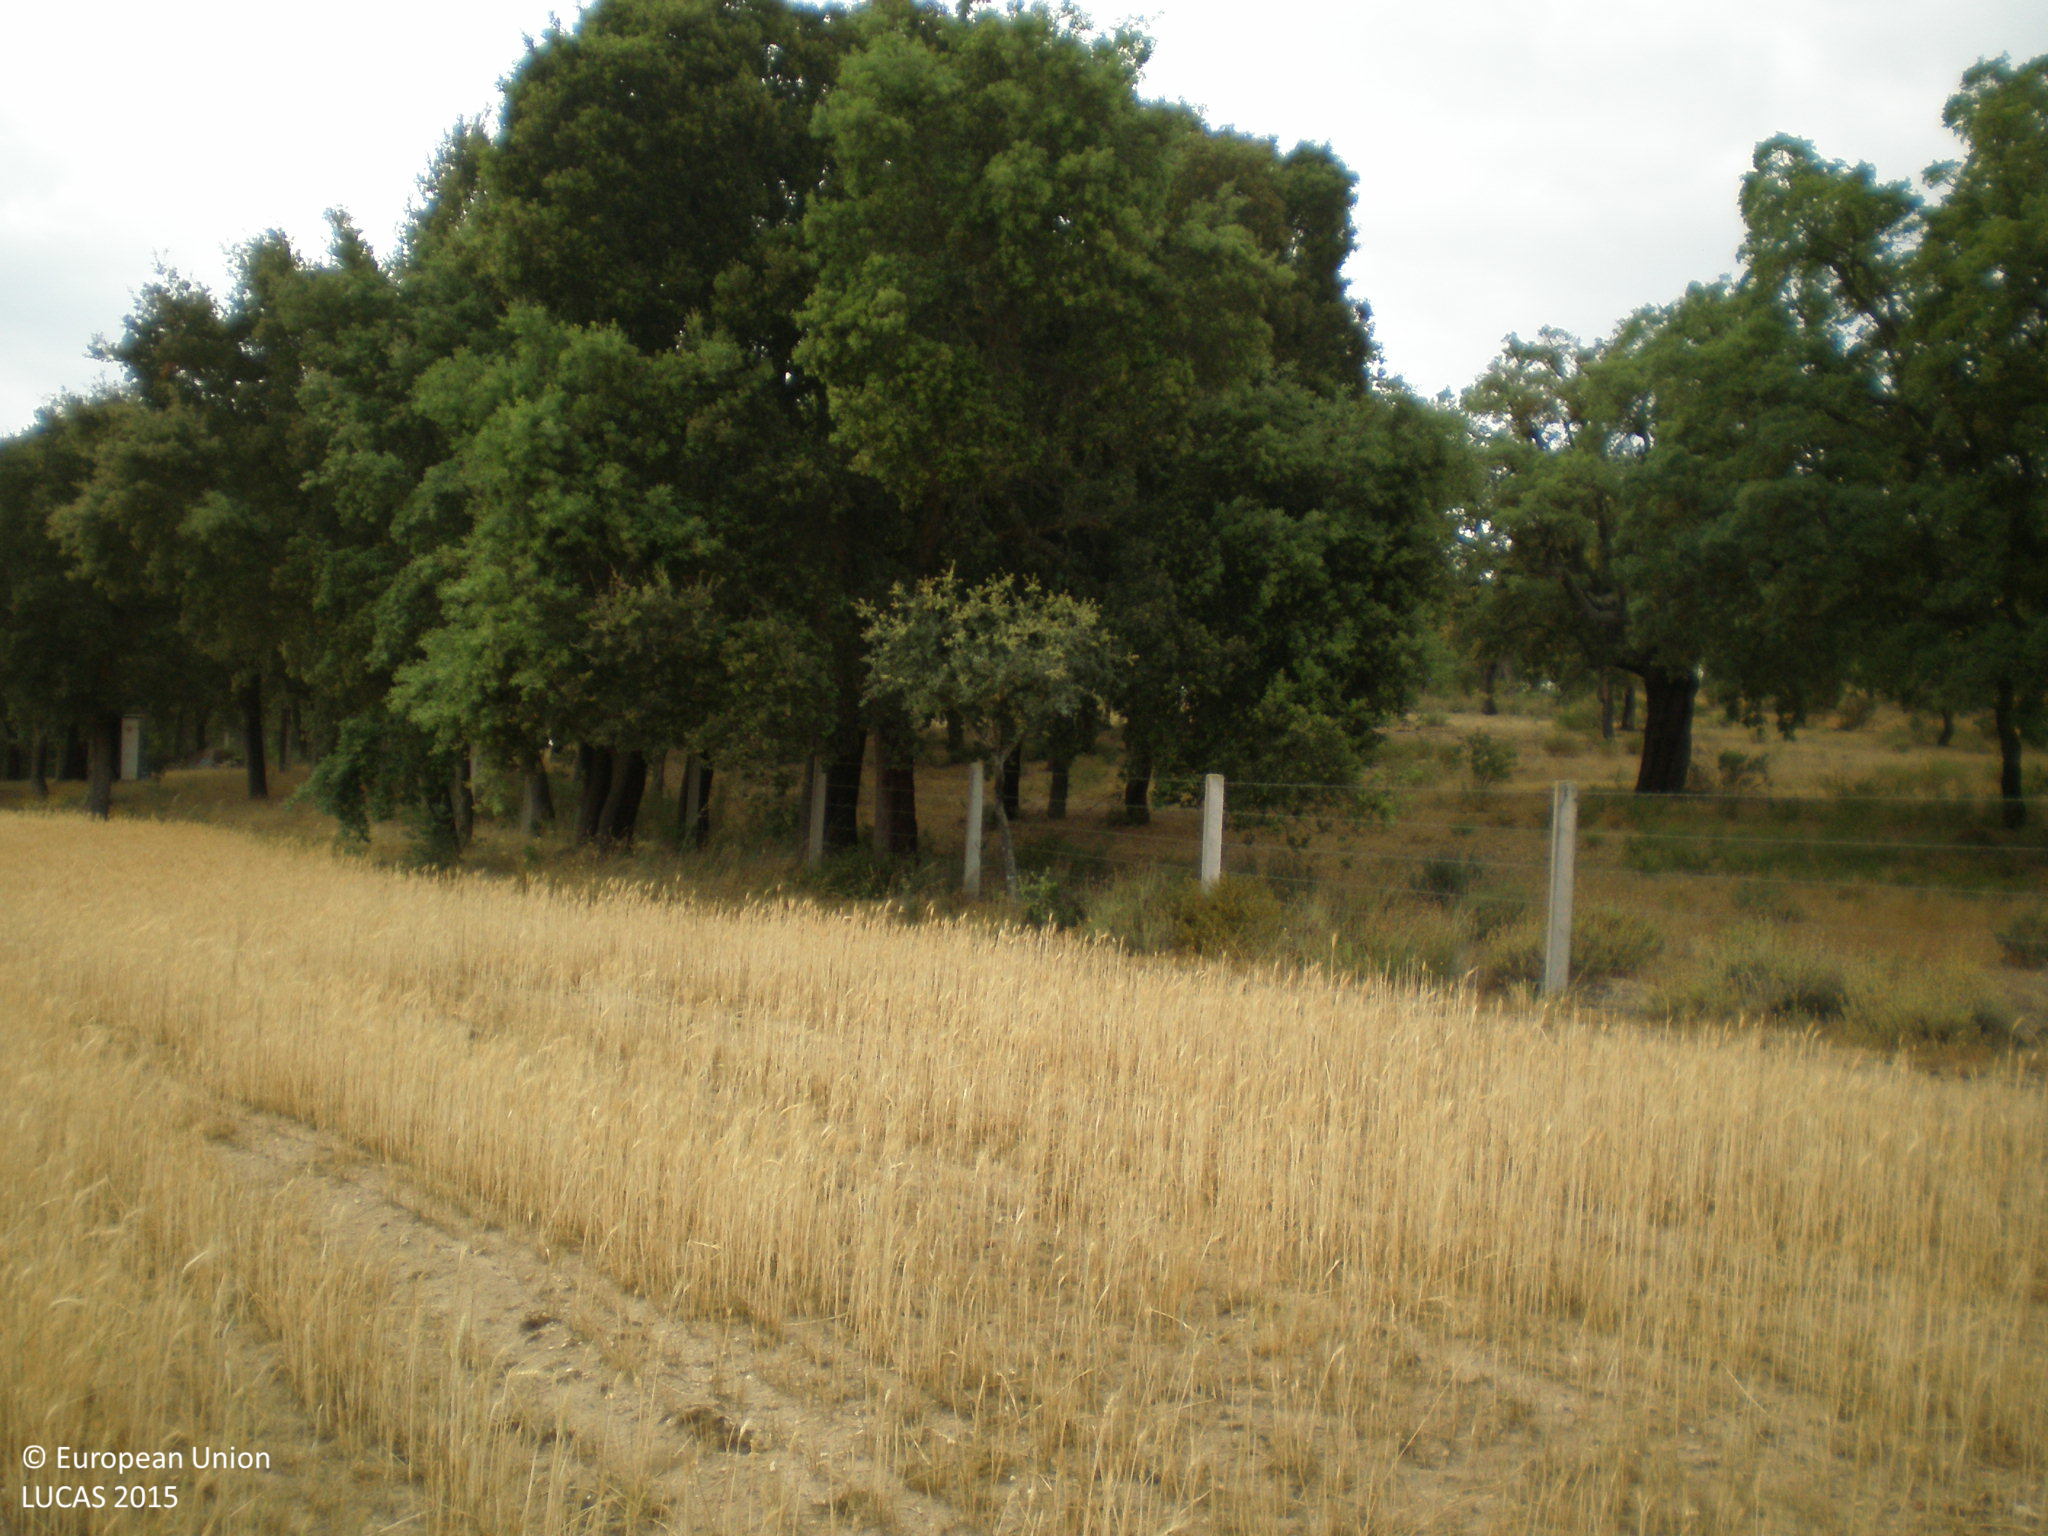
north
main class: Cropland
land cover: Triticale
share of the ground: > 75 %
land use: Agriculture (excluding fallow land and kitchen gardens)
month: June
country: ES
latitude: 41.1654
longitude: -5.8032
